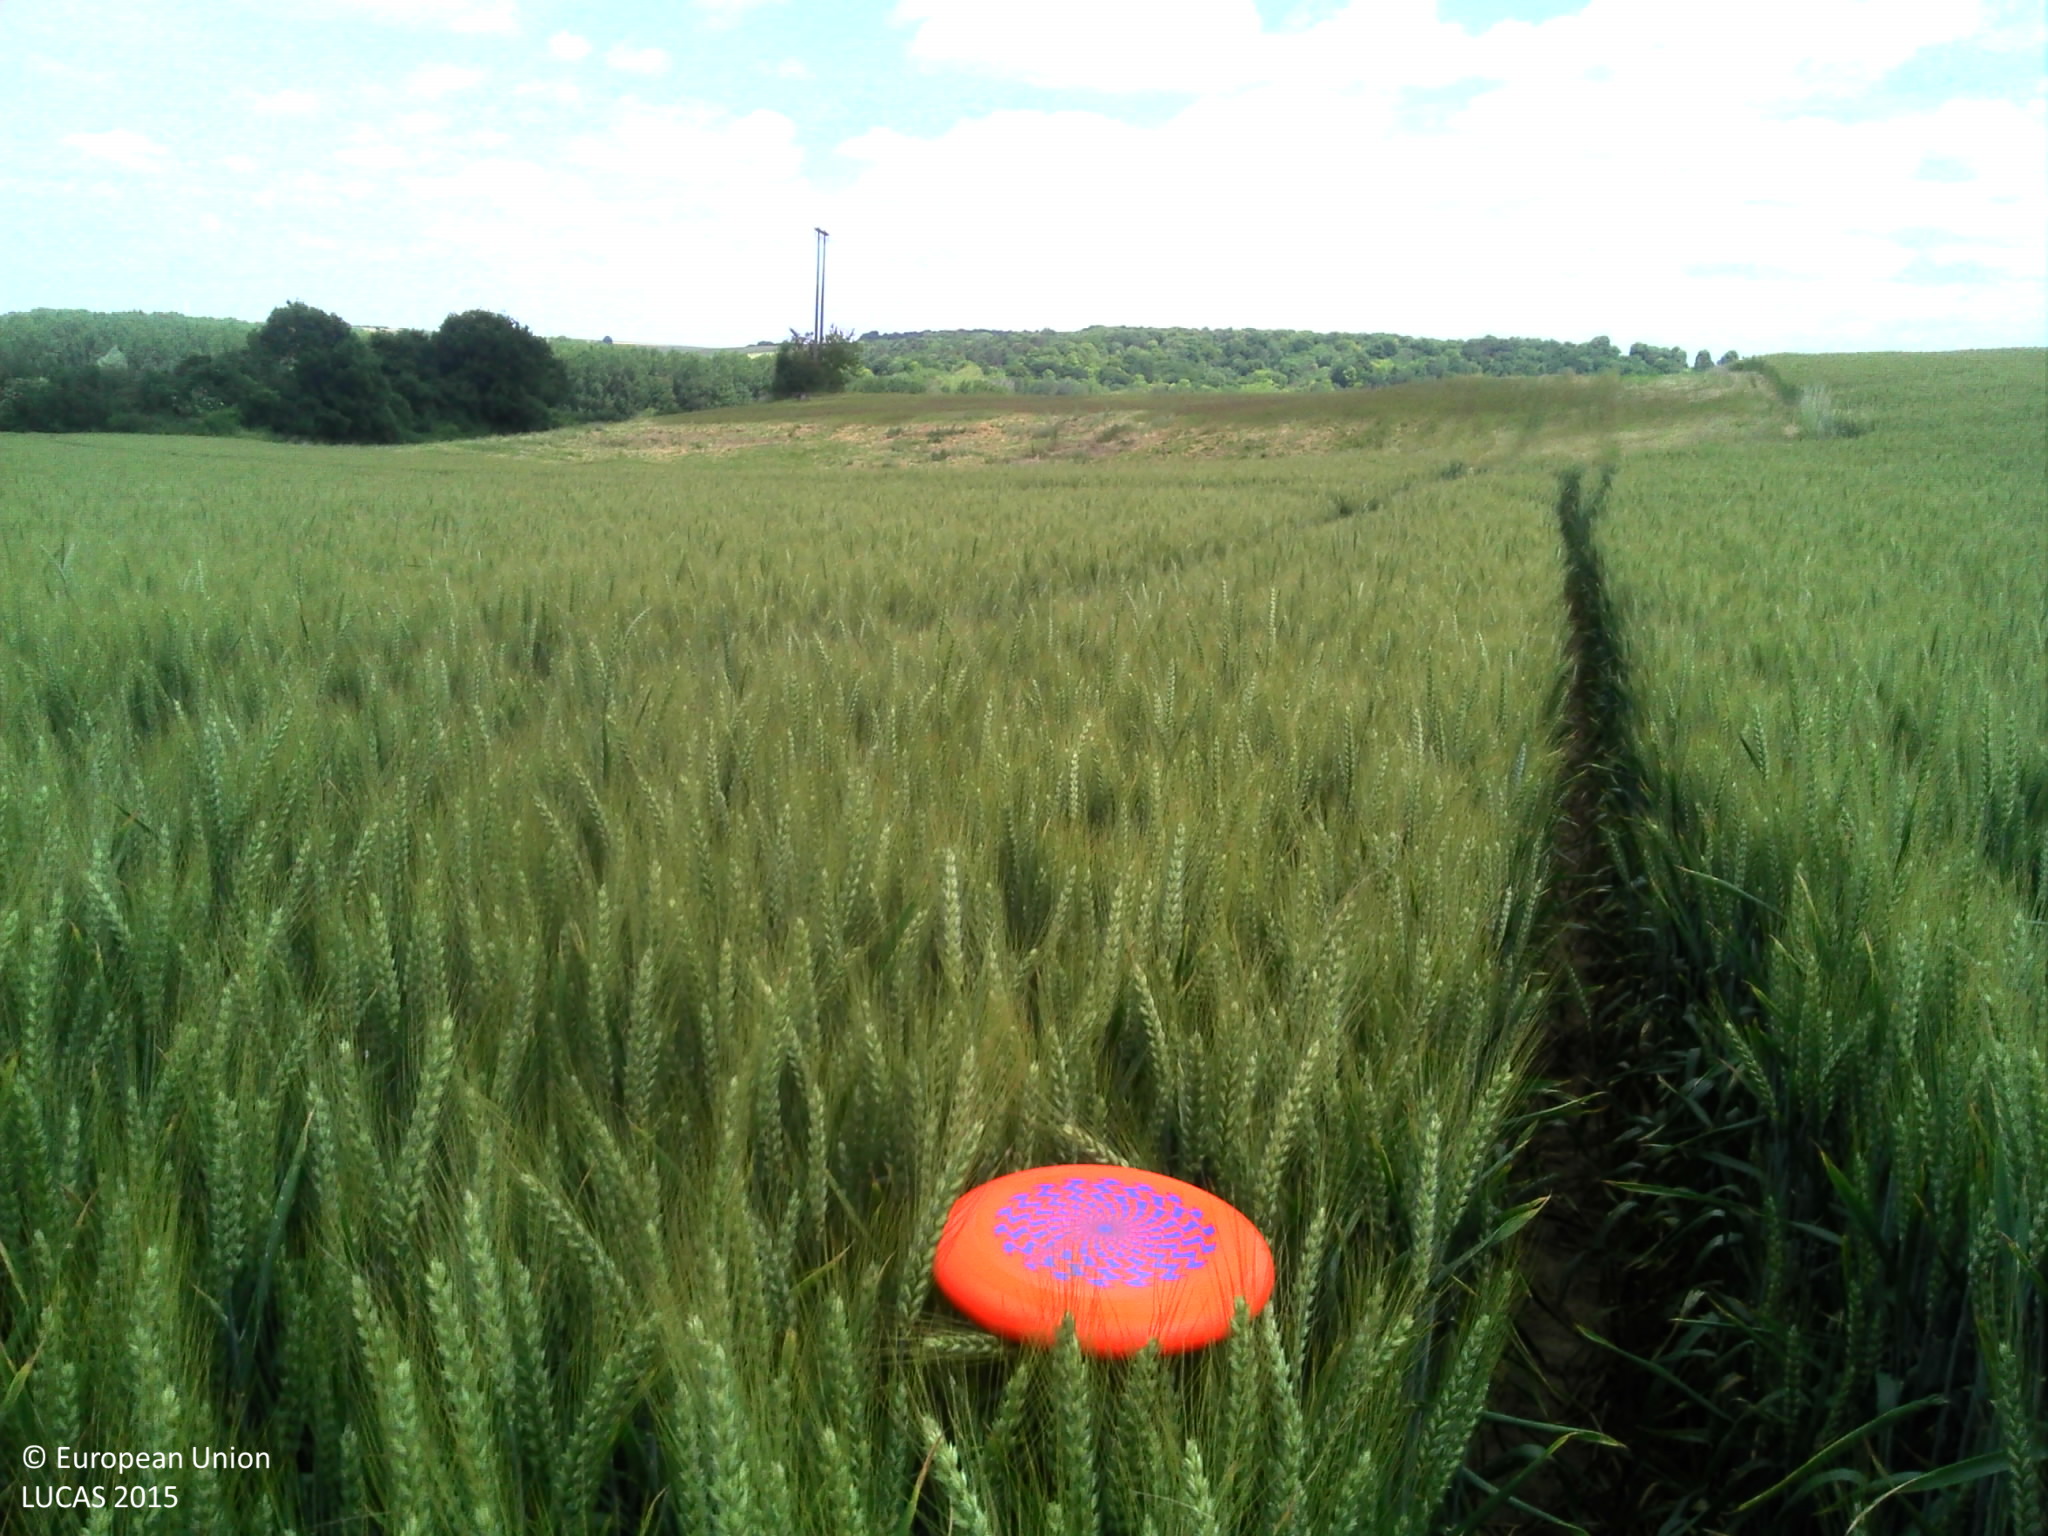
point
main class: Cropland
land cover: Durum wheat
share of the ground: > 75 %
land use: Agriculture (excluding fallow land and kitchen gardens)
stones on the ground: < 10 %
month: June
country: FR
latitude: 49.6675
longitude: 2.5199
